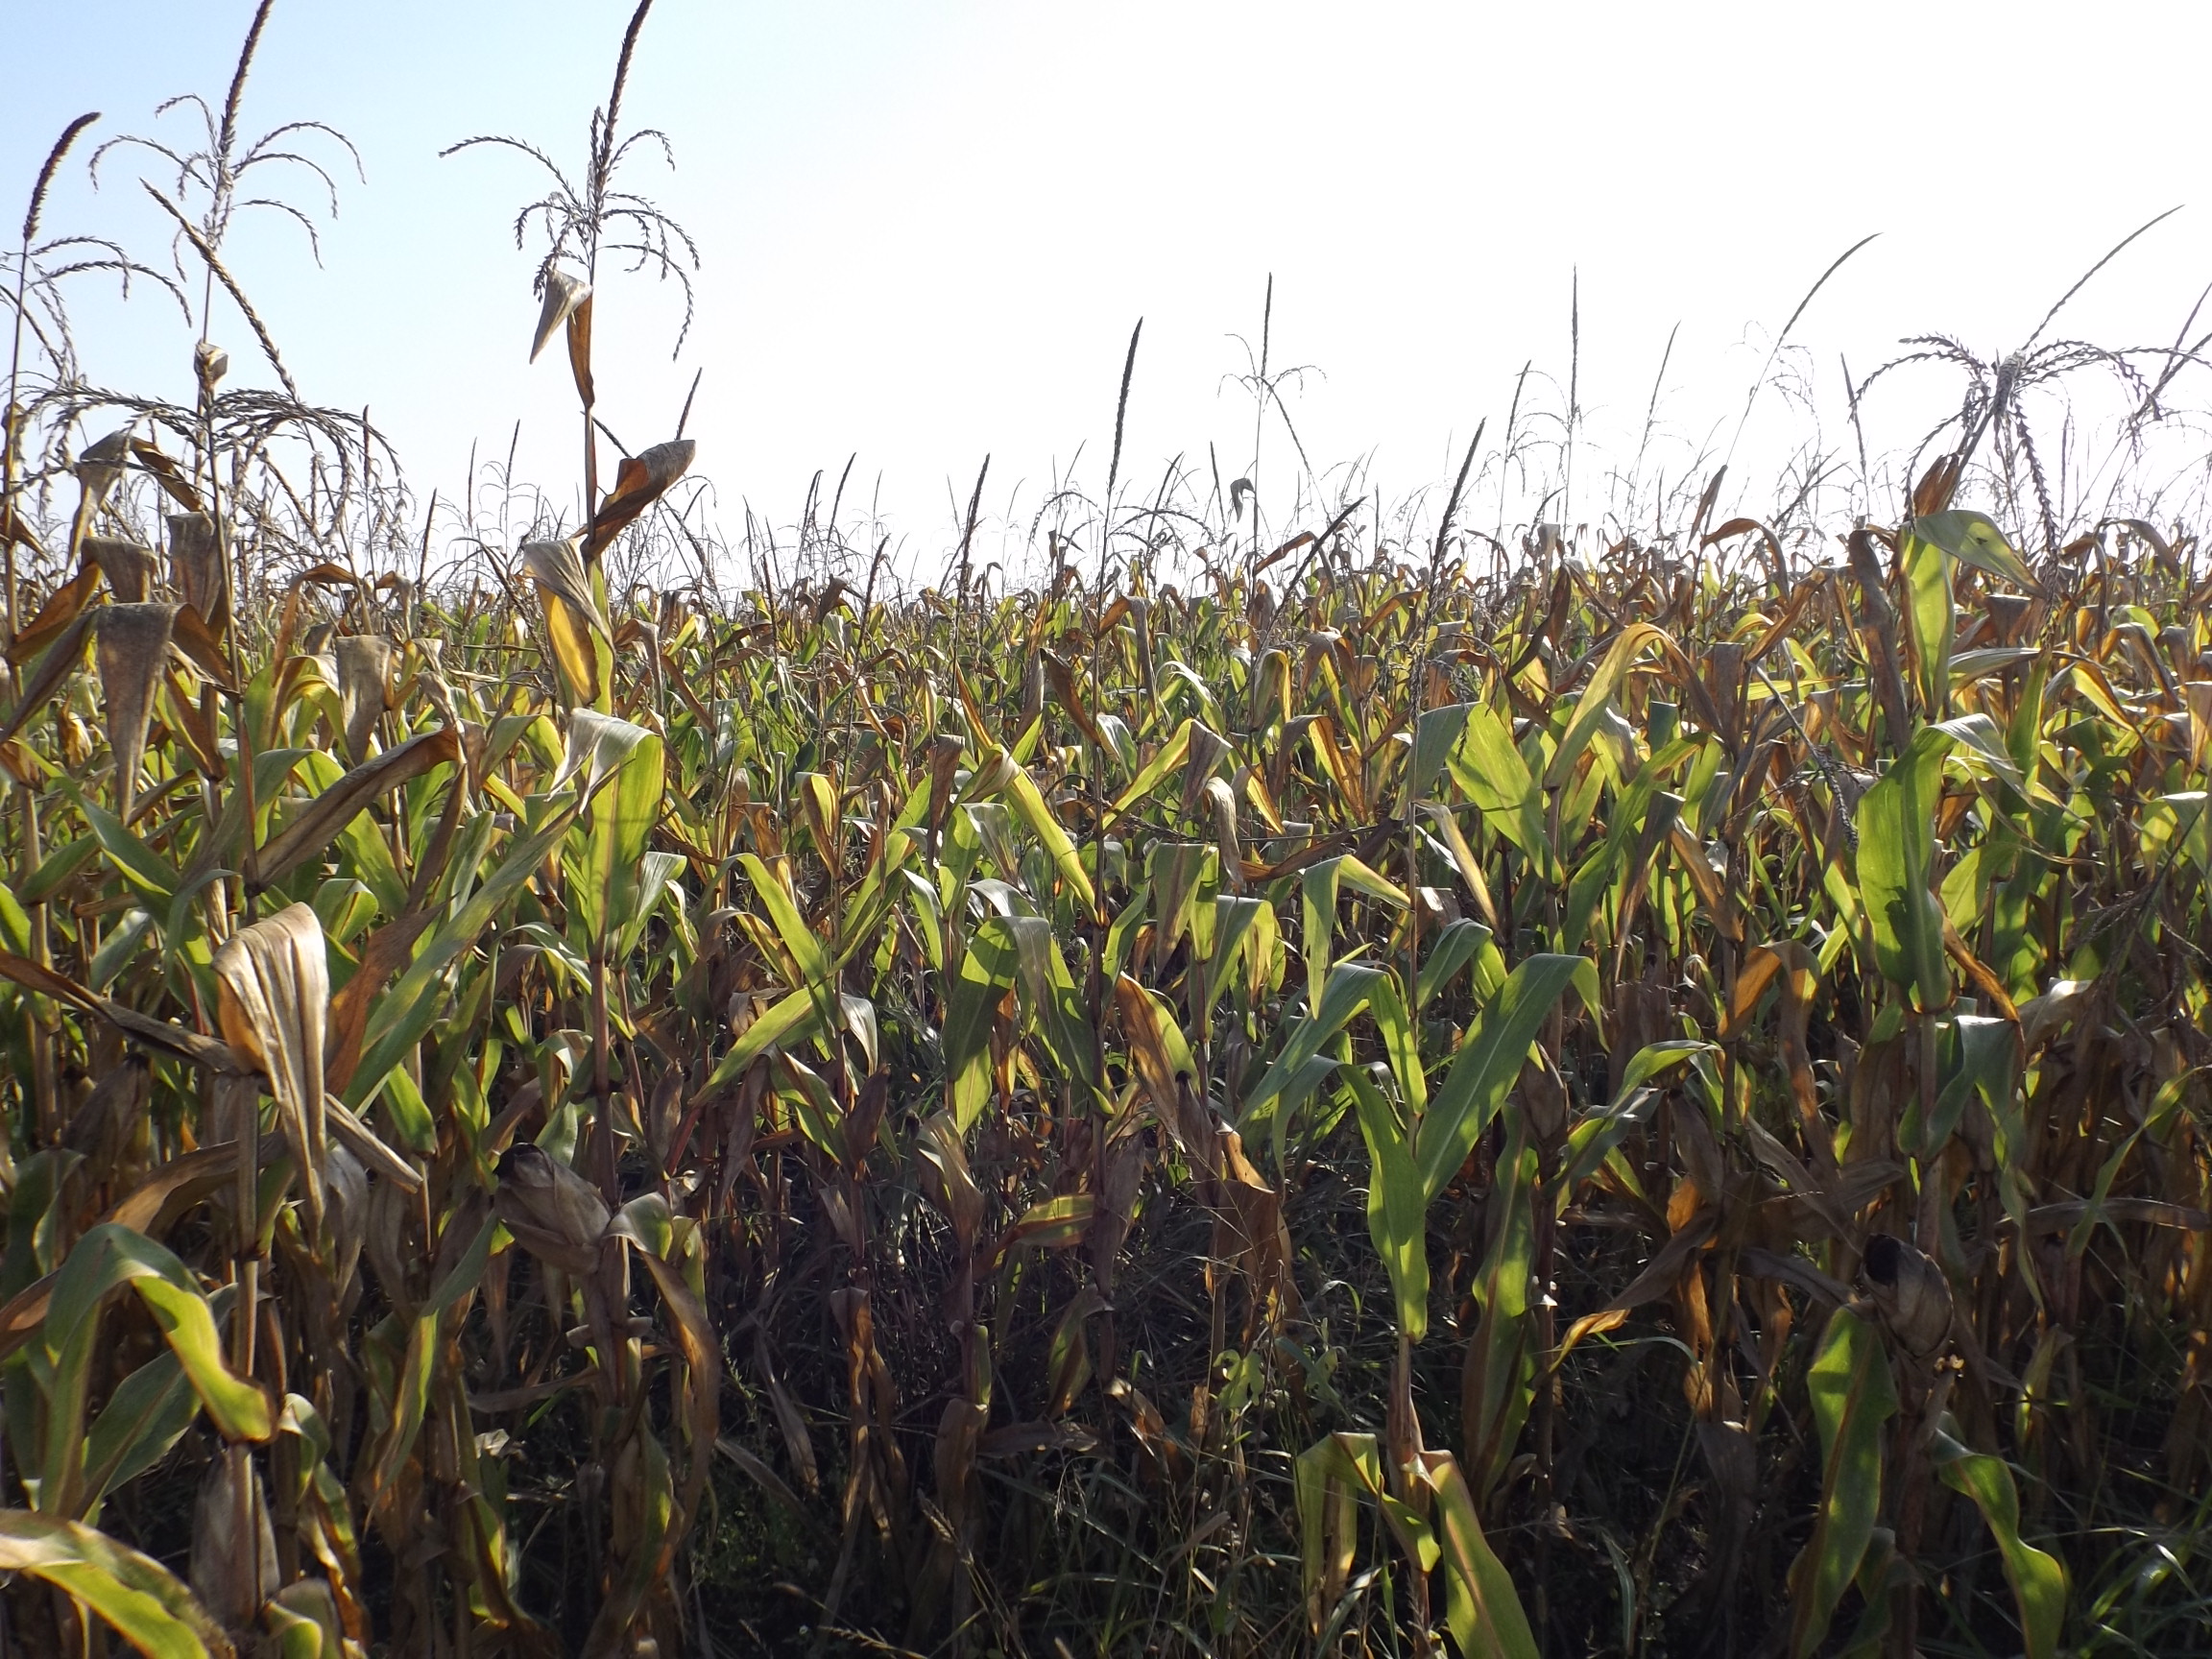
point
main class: Cropland
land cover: Maize
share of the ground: > 75 %
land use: Agriculture (excluding fallow land and kitchen gardens)
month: September
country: BG
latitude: 44.0073
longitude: 26.4096
